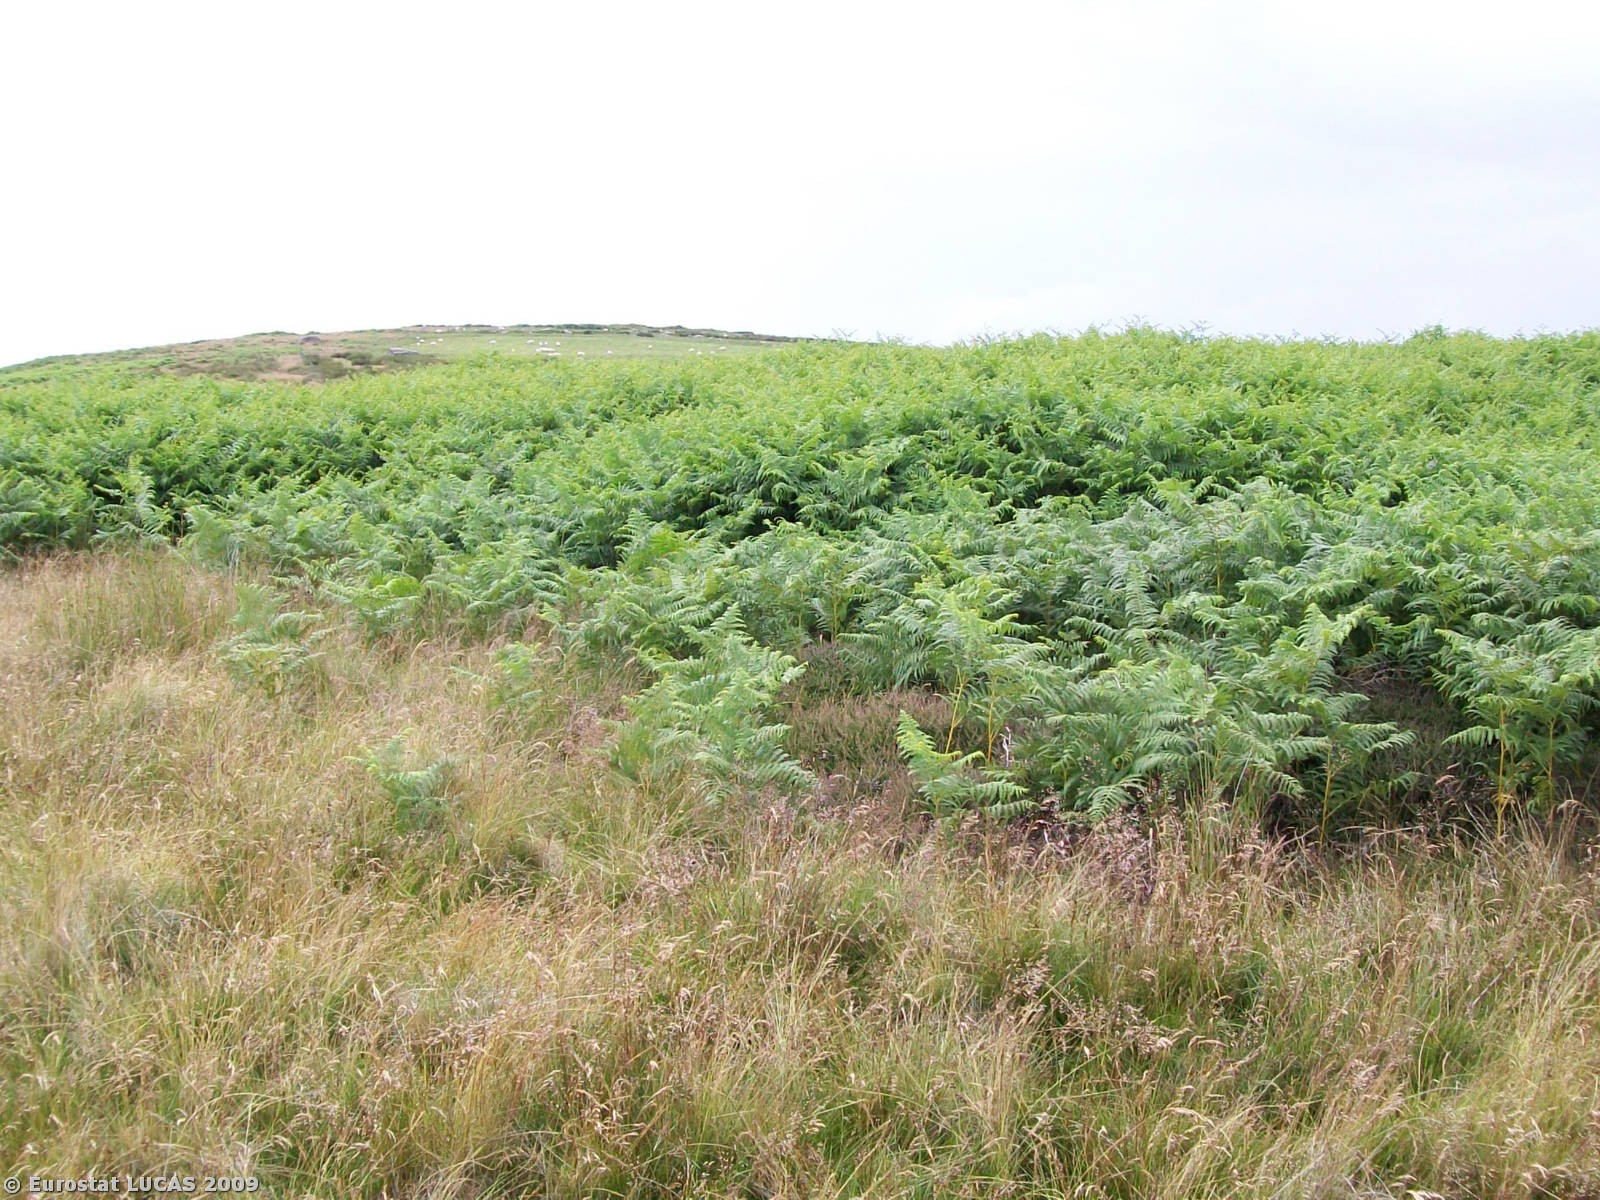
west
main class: Shrubland
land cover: Shrubland without tree cover
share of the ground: > 75 %
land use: Agriculture (excluding fallow land and kitchen gardens)
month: July
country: GB
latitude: 55.4886
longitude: -1.8733
